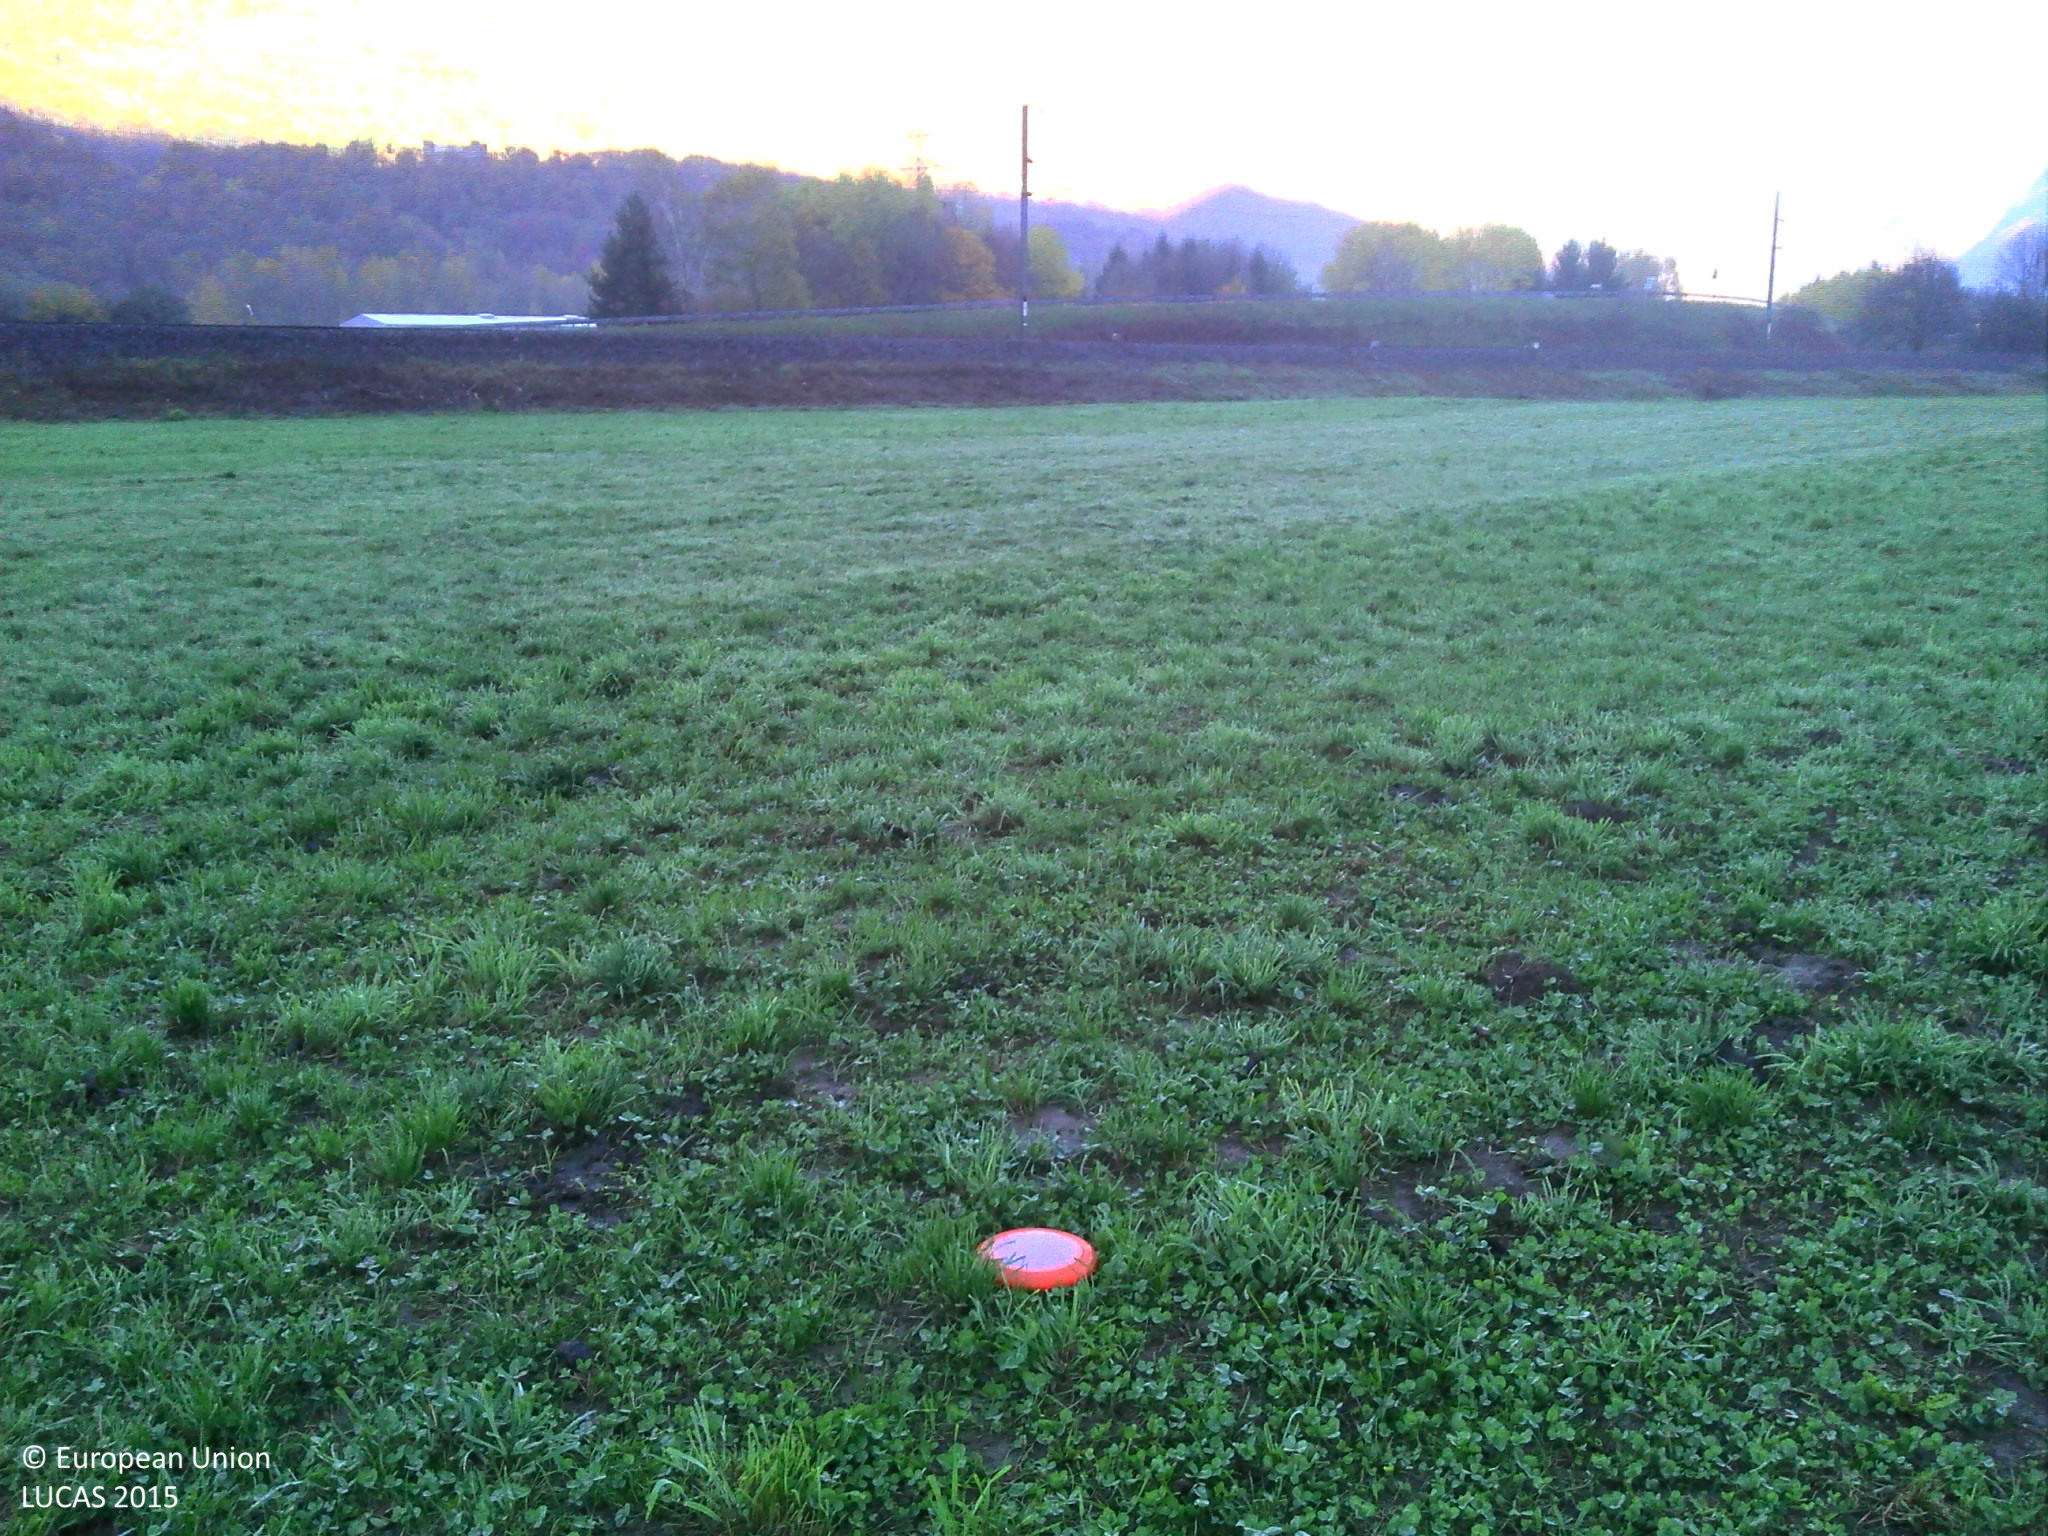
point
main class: Grassland
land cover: Grassland without tree/shrub cover
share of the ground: > 75 %
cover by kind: herbaceous plants 100 %
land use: Agriculture (excluding fallow land and kitchen gardens)
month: October
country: FR
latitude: 45.6072
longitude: 6.4527
